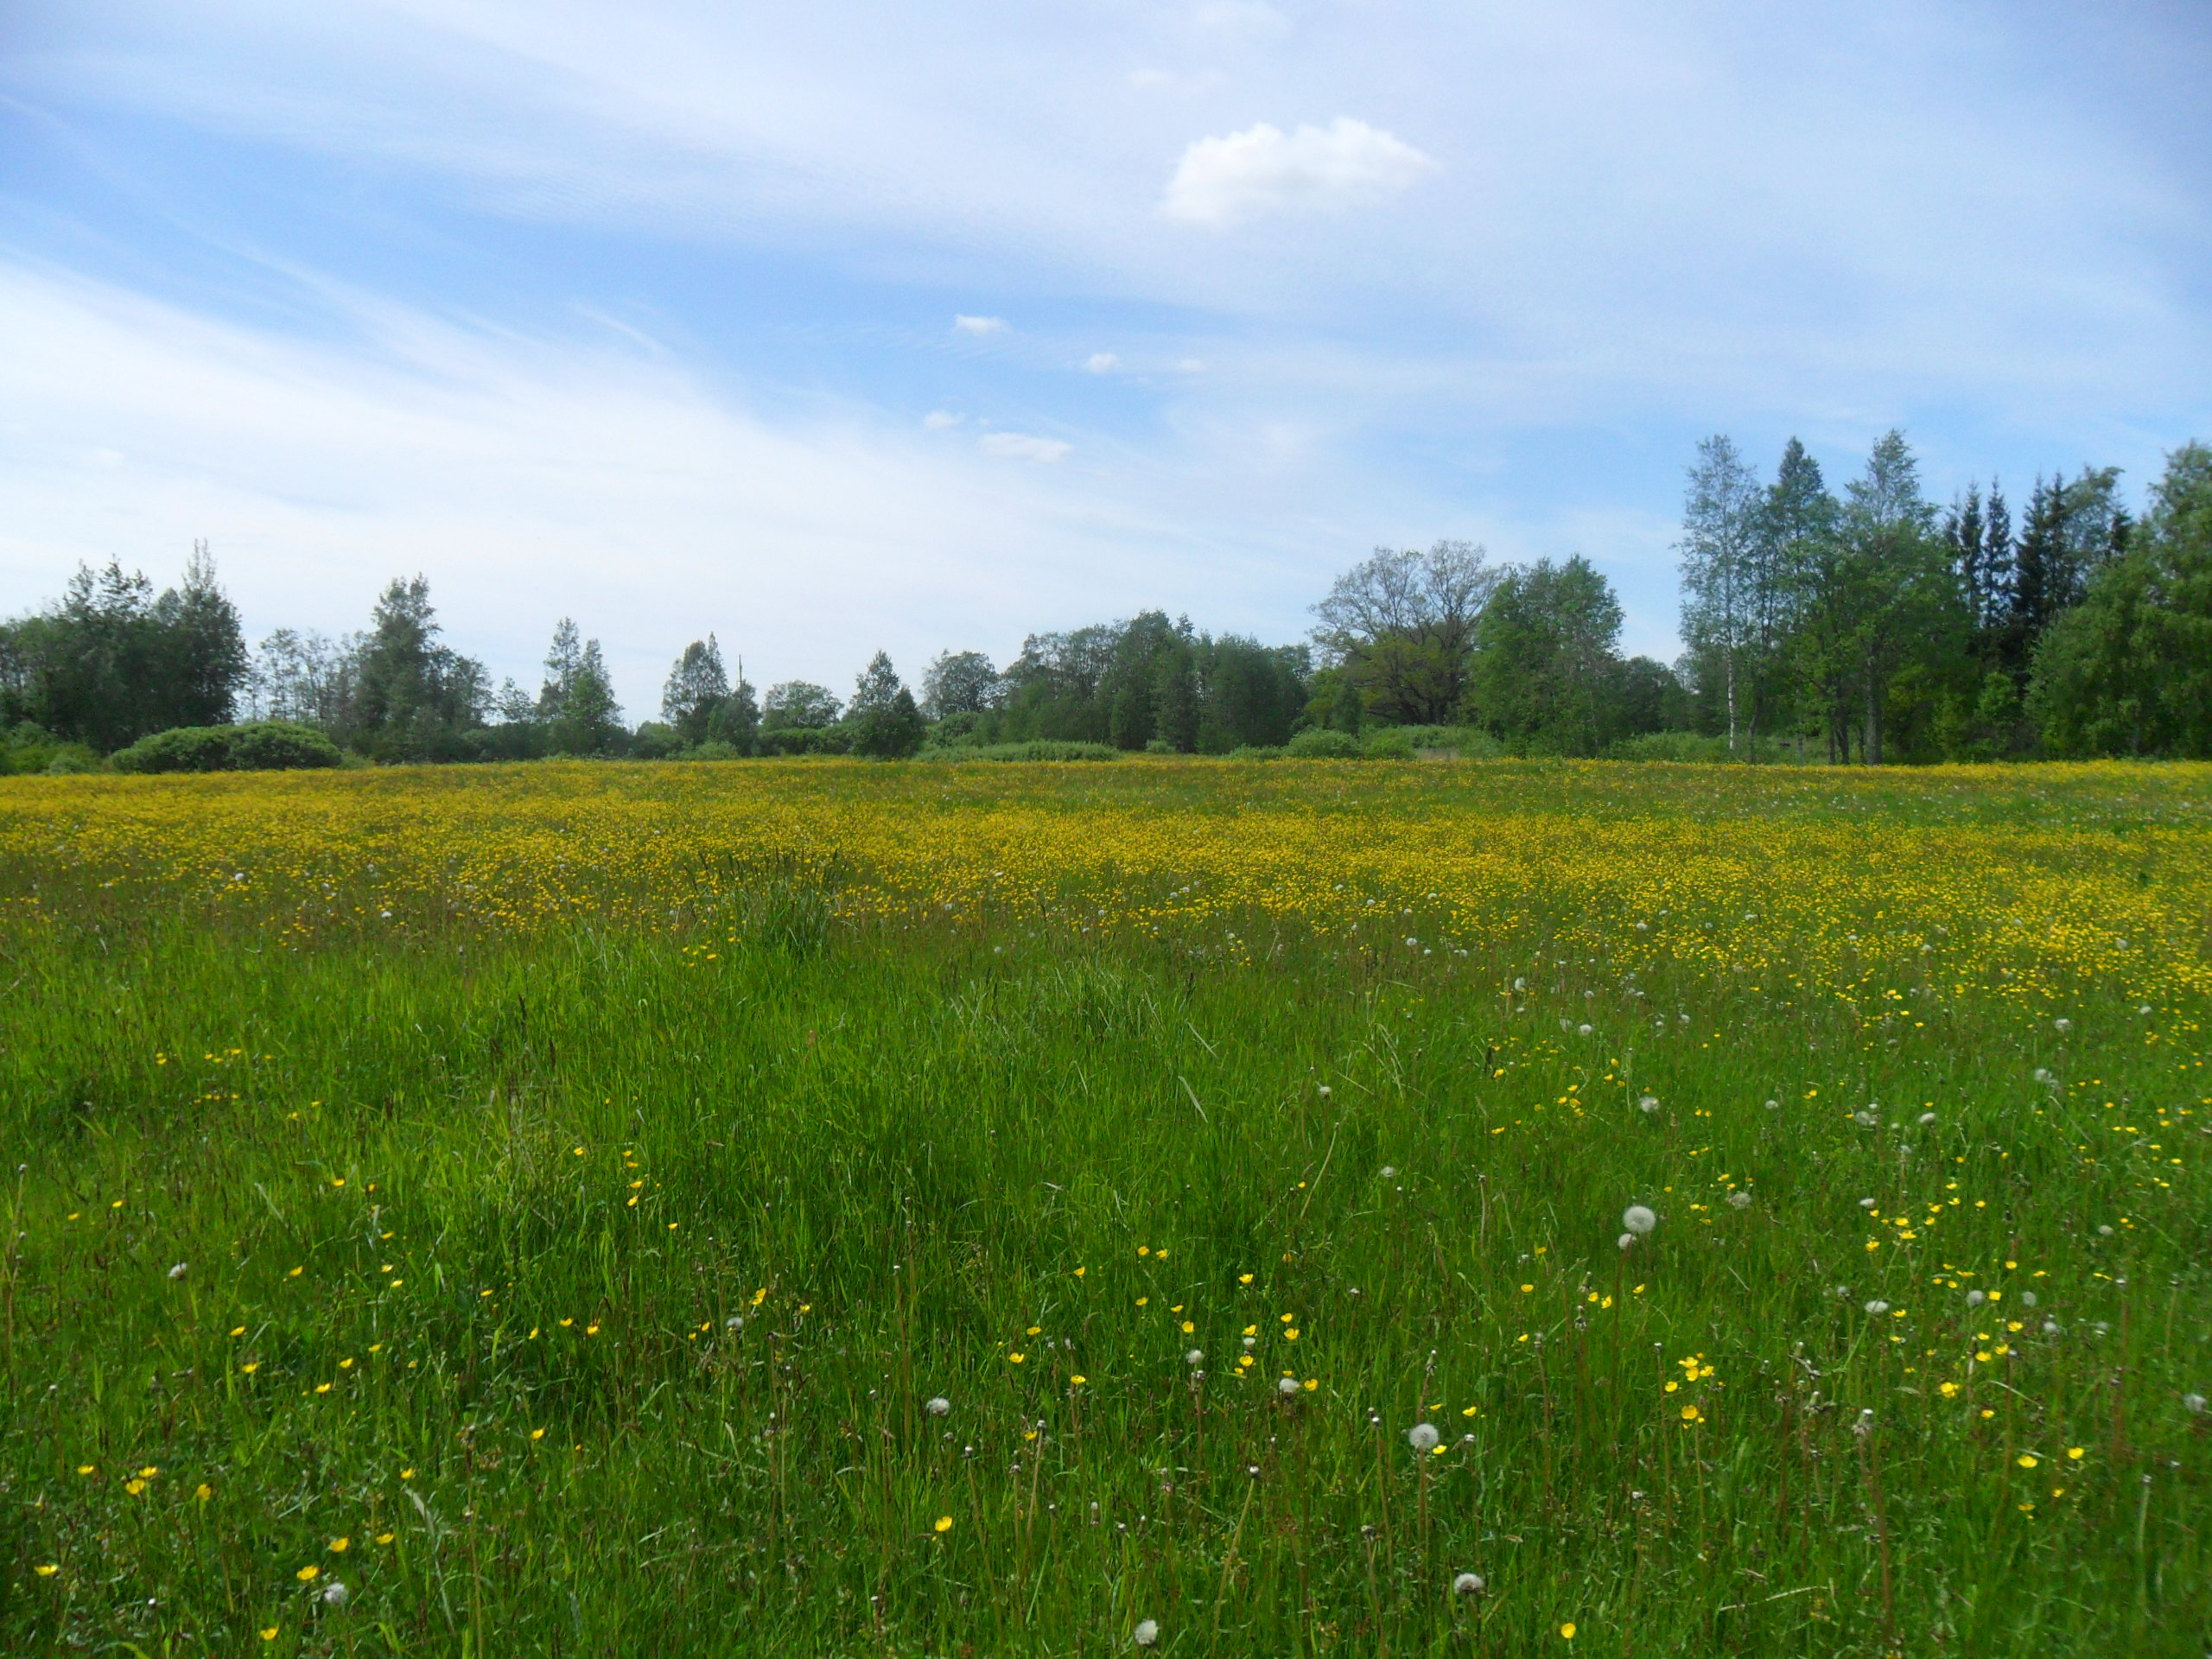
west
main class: Grassland
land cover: Grassland without tree/shrub cover
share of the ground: > 75 %
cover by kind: herbaceous plants 100 %
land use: Agriculture (excluding fallow land and kitchen gardens)
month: June
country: LV
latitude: 57.4007
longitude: 22.4508
